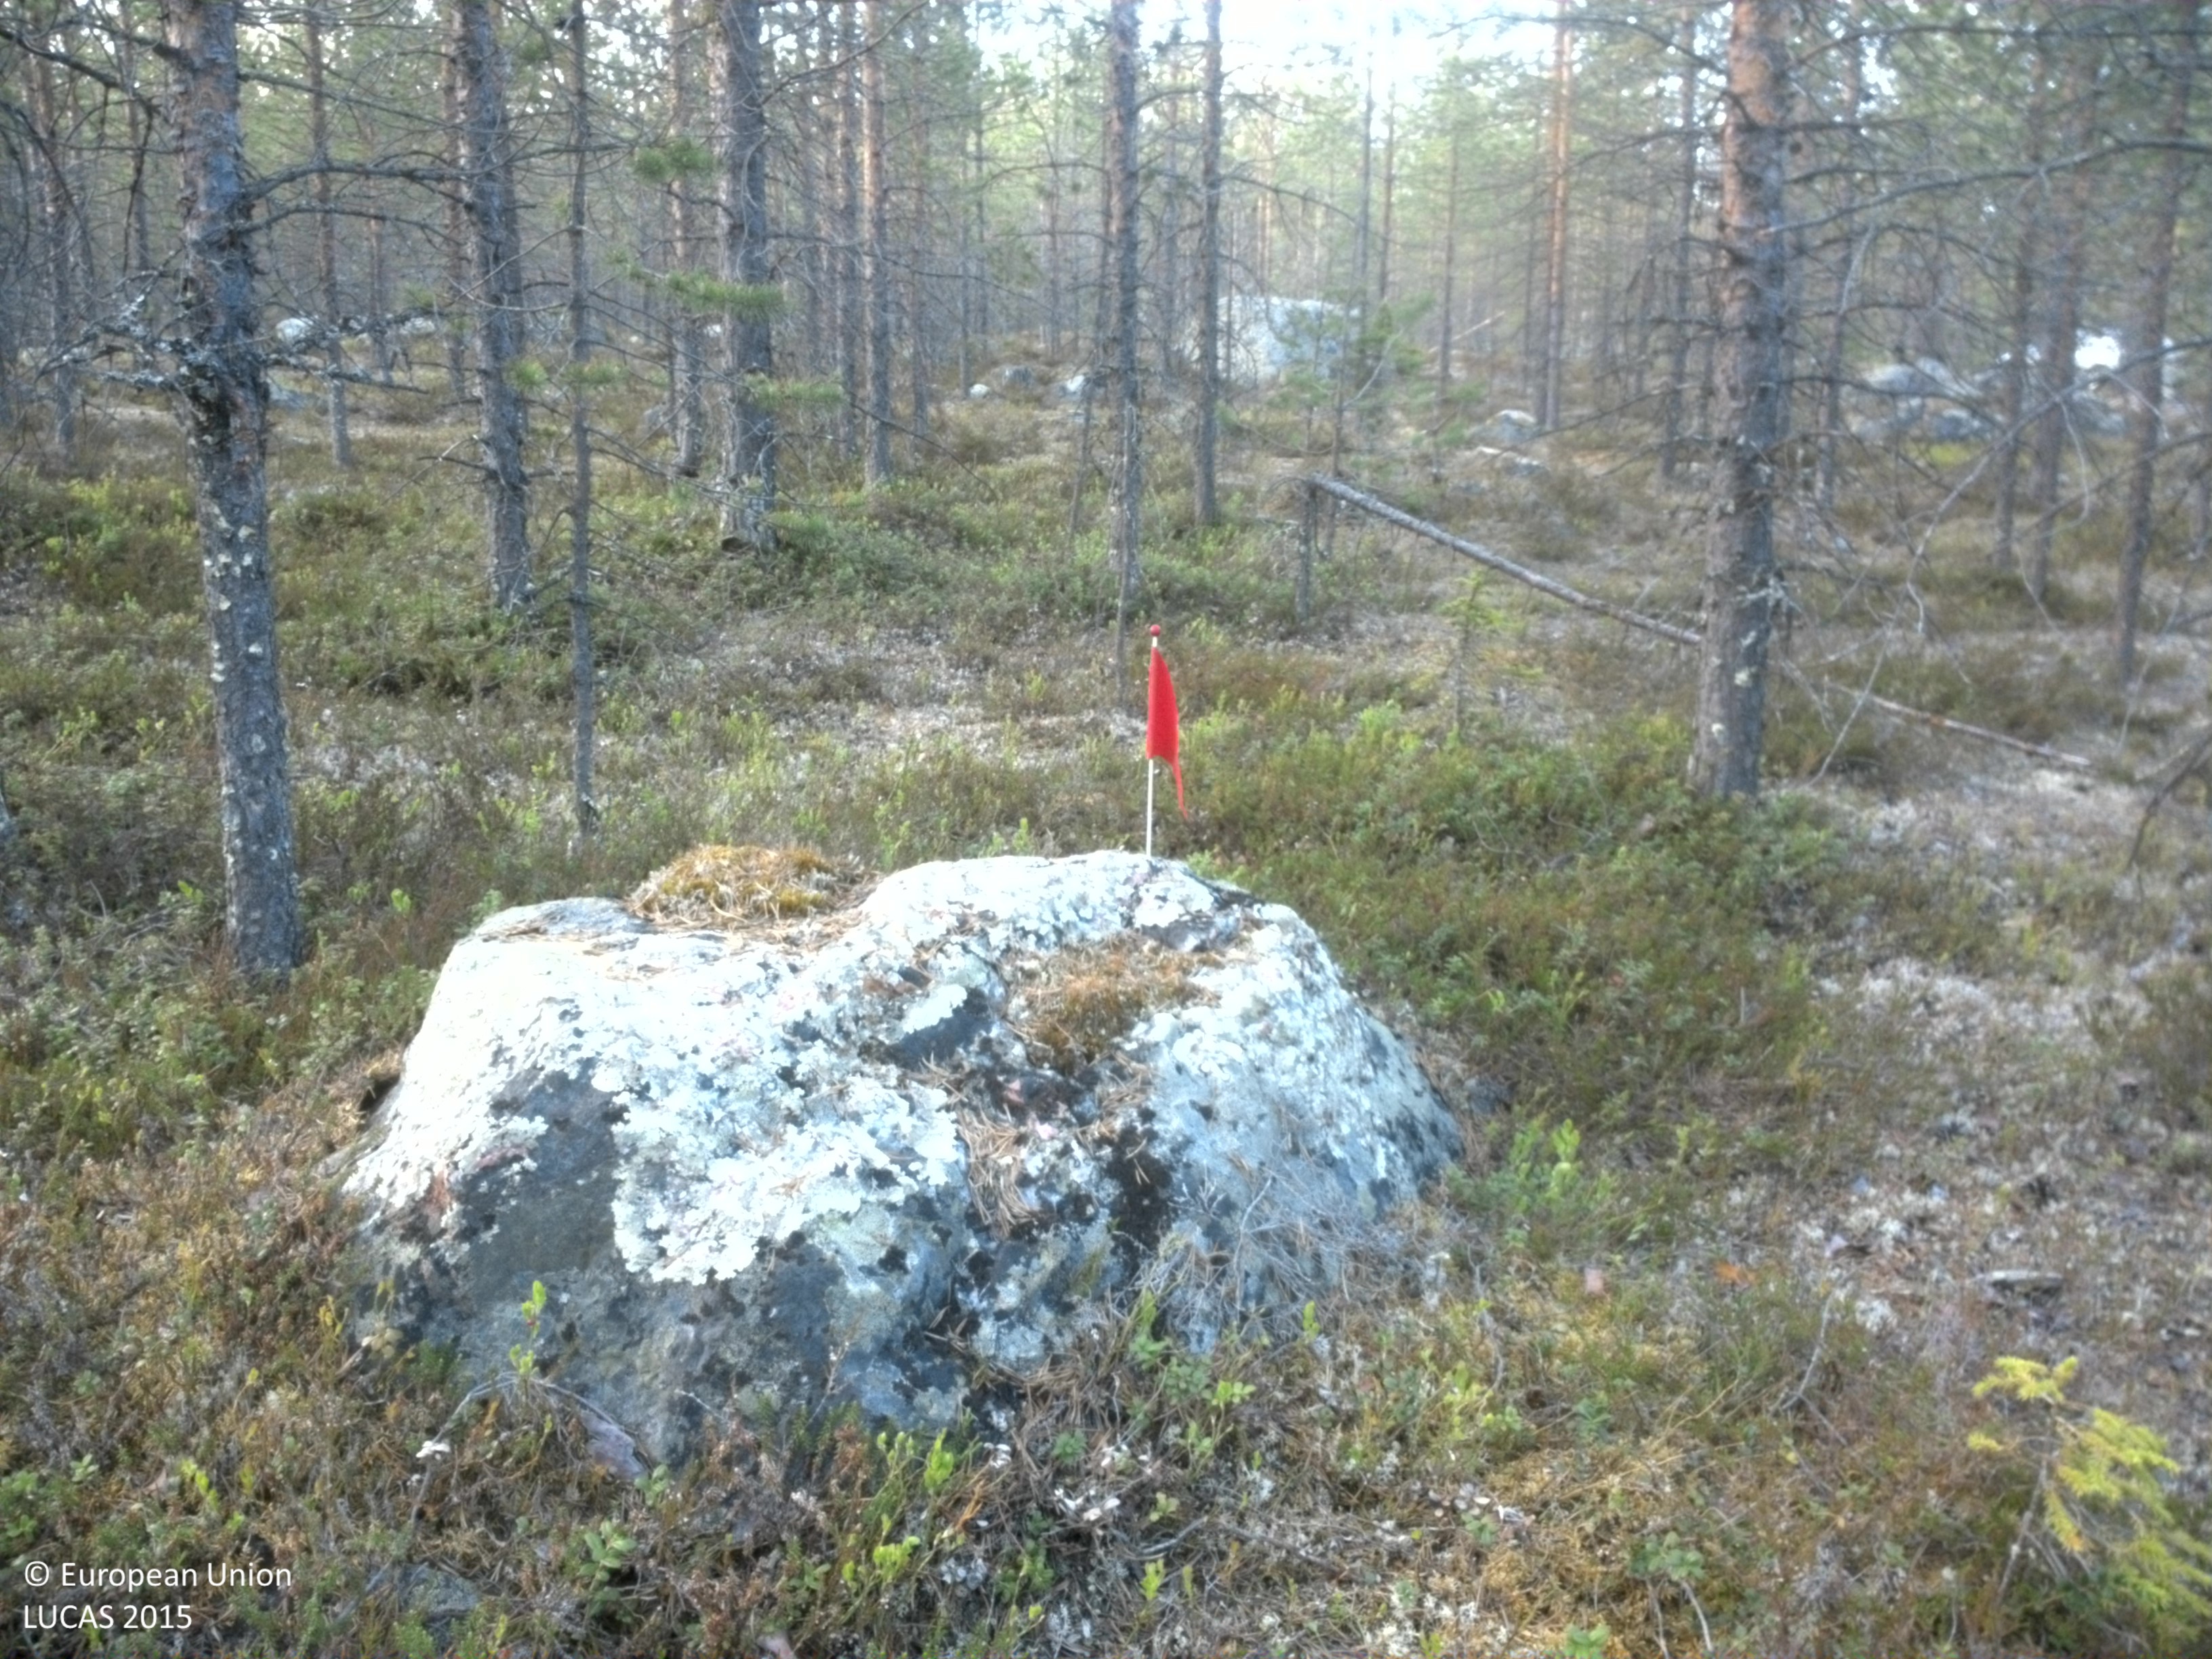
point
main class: Woodland
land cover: Pine dominated coniferous woodland
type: boreal forest
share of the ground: 25 - 50 %
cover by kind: shrubs 40 %, lichens and mosses 30 %, coniferous forest trees 25 %, unconsolidated bare surface 5 %
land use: Forestry
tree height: > 5 m
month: June
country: SE
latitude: 66.9029
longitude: 21.8618
